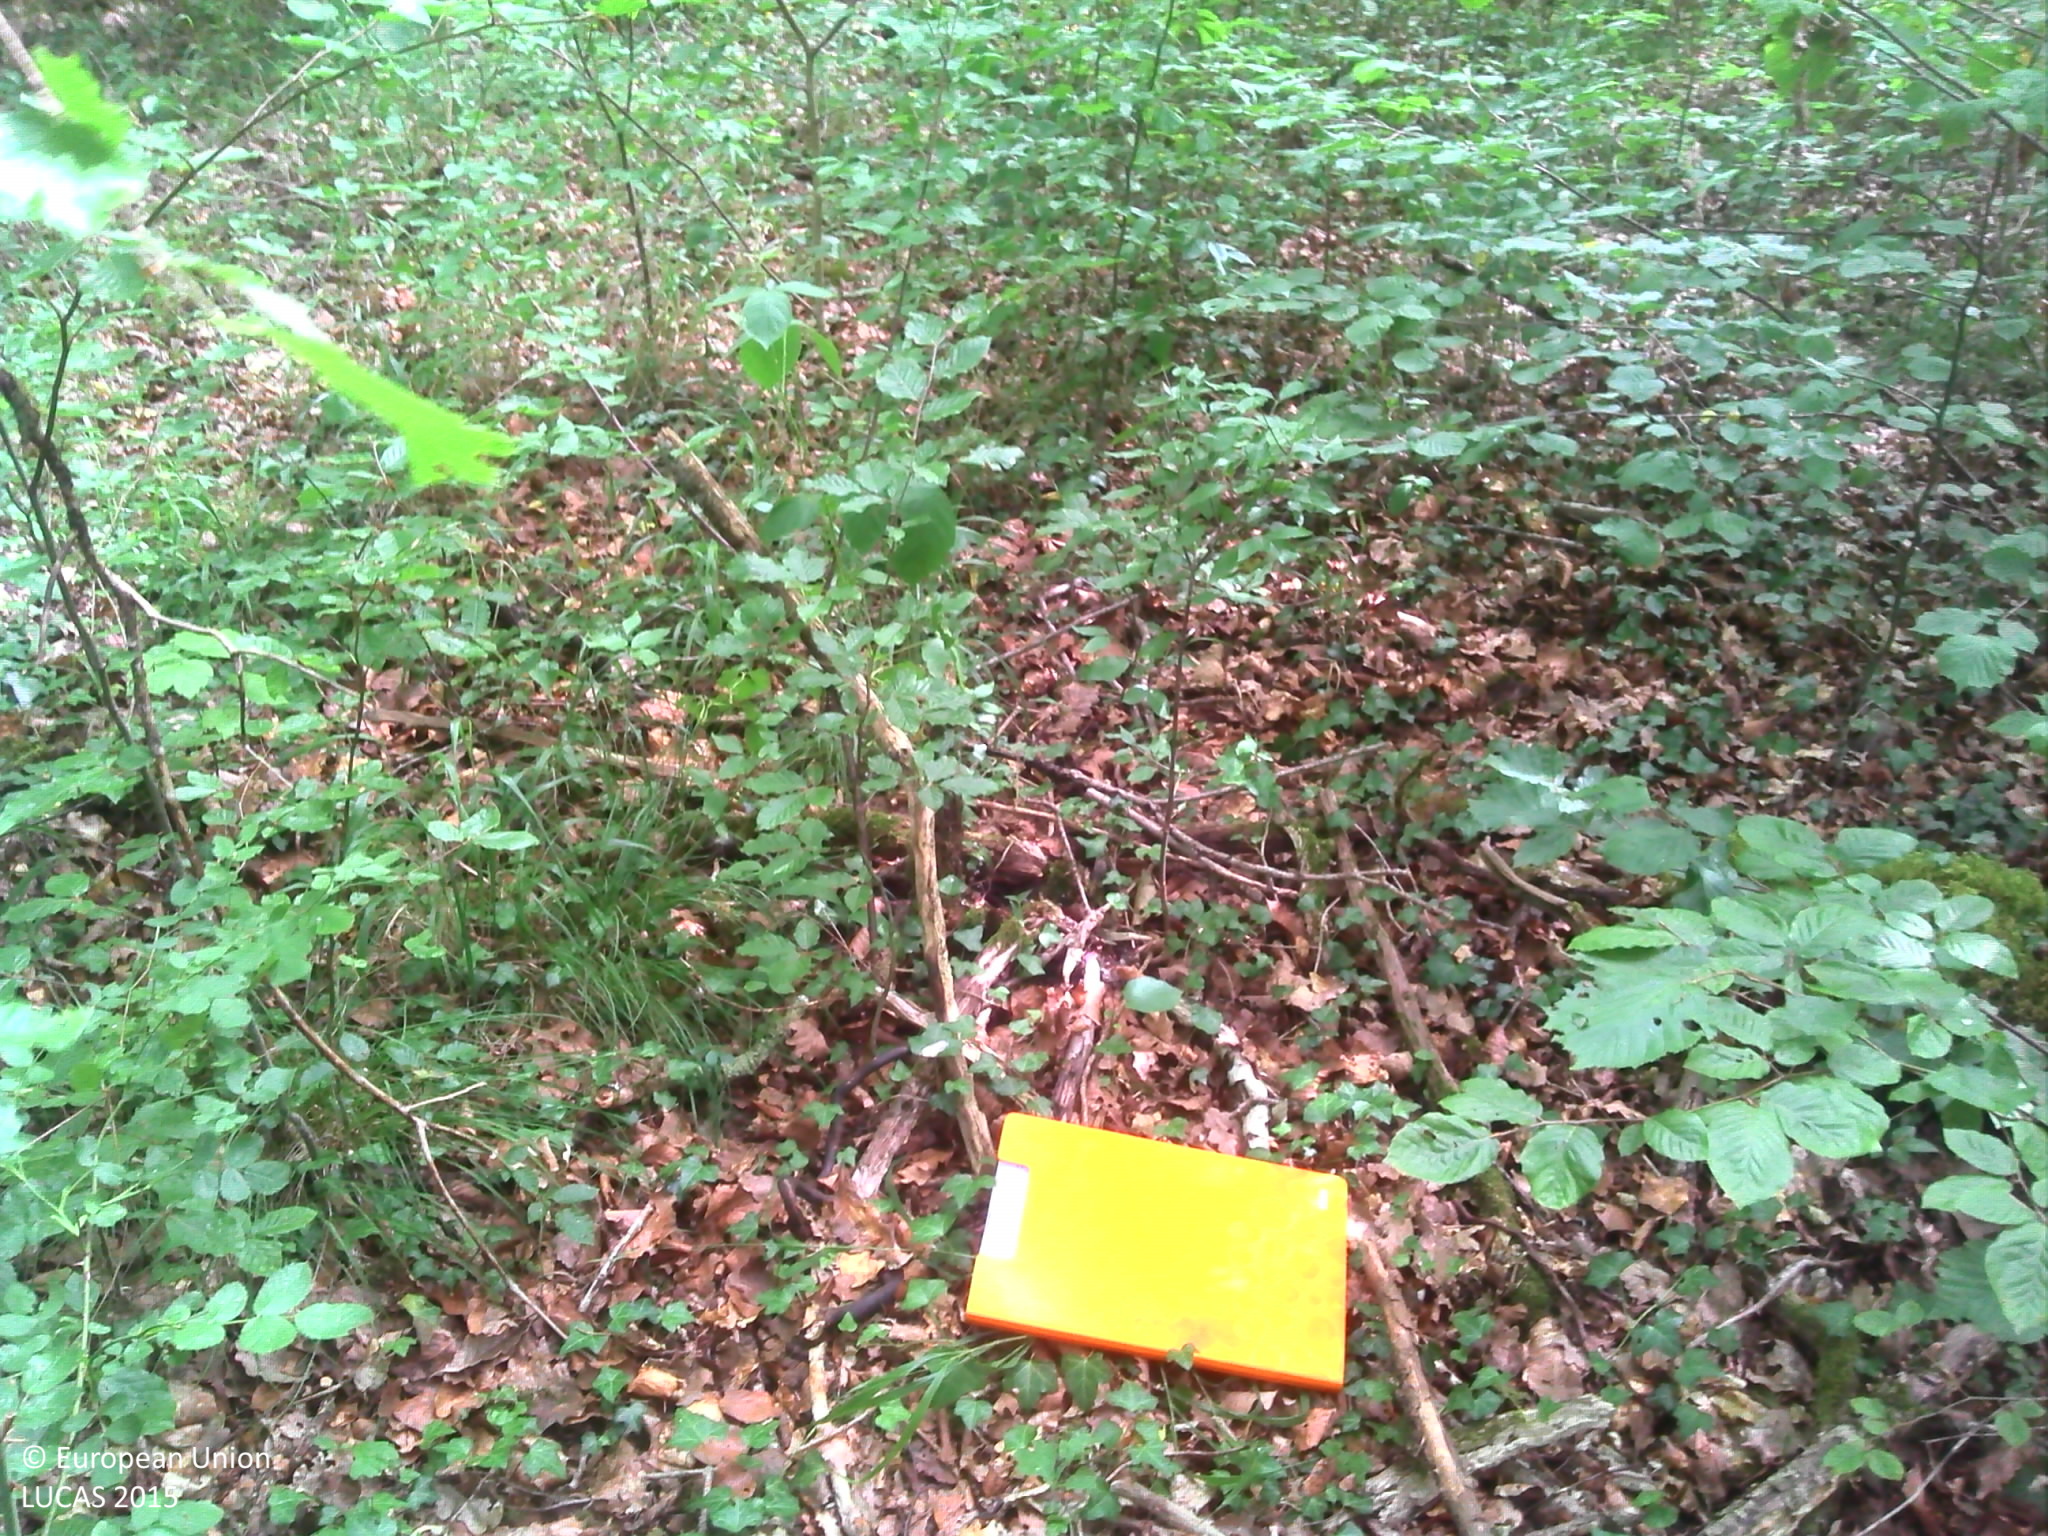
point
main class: Woodland
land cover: Broadleaved woodland
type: acidophilous oak and oak-birch forest
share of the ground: > 75 %
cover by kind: broadleaved forest trees 80 %, herbaceous plants 10 %, lichens and mosses 10 %
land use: Forestry
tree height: > 5 m
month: July
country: FR
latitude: 47.9110
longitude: 4.9819
